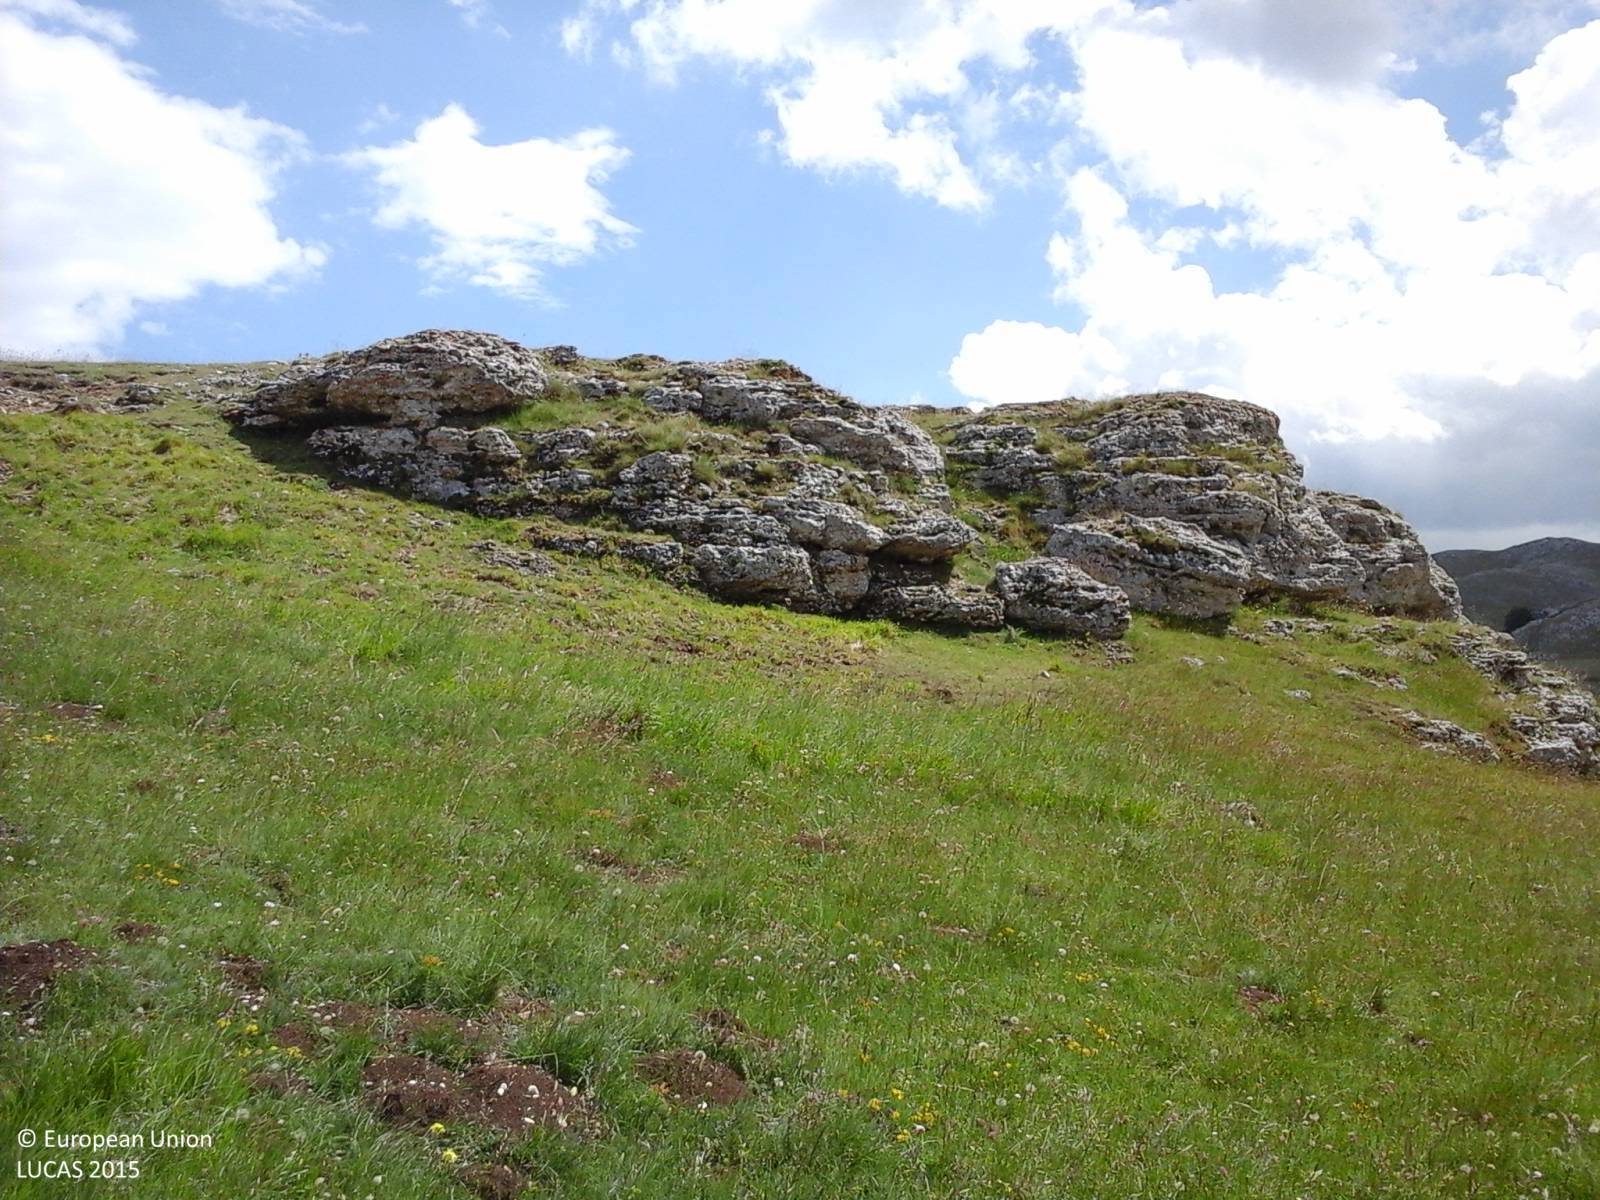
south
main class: Grassland
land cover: Grassland without tree/shrub cover
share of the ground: > 75 %
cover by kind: herbaceous plants 100 %
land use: Agriculture (excluding fallow land and kitchen gardens)
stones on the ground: 10 - 25 %
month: June
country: IT
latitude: 42.4041
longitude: 13.7427
